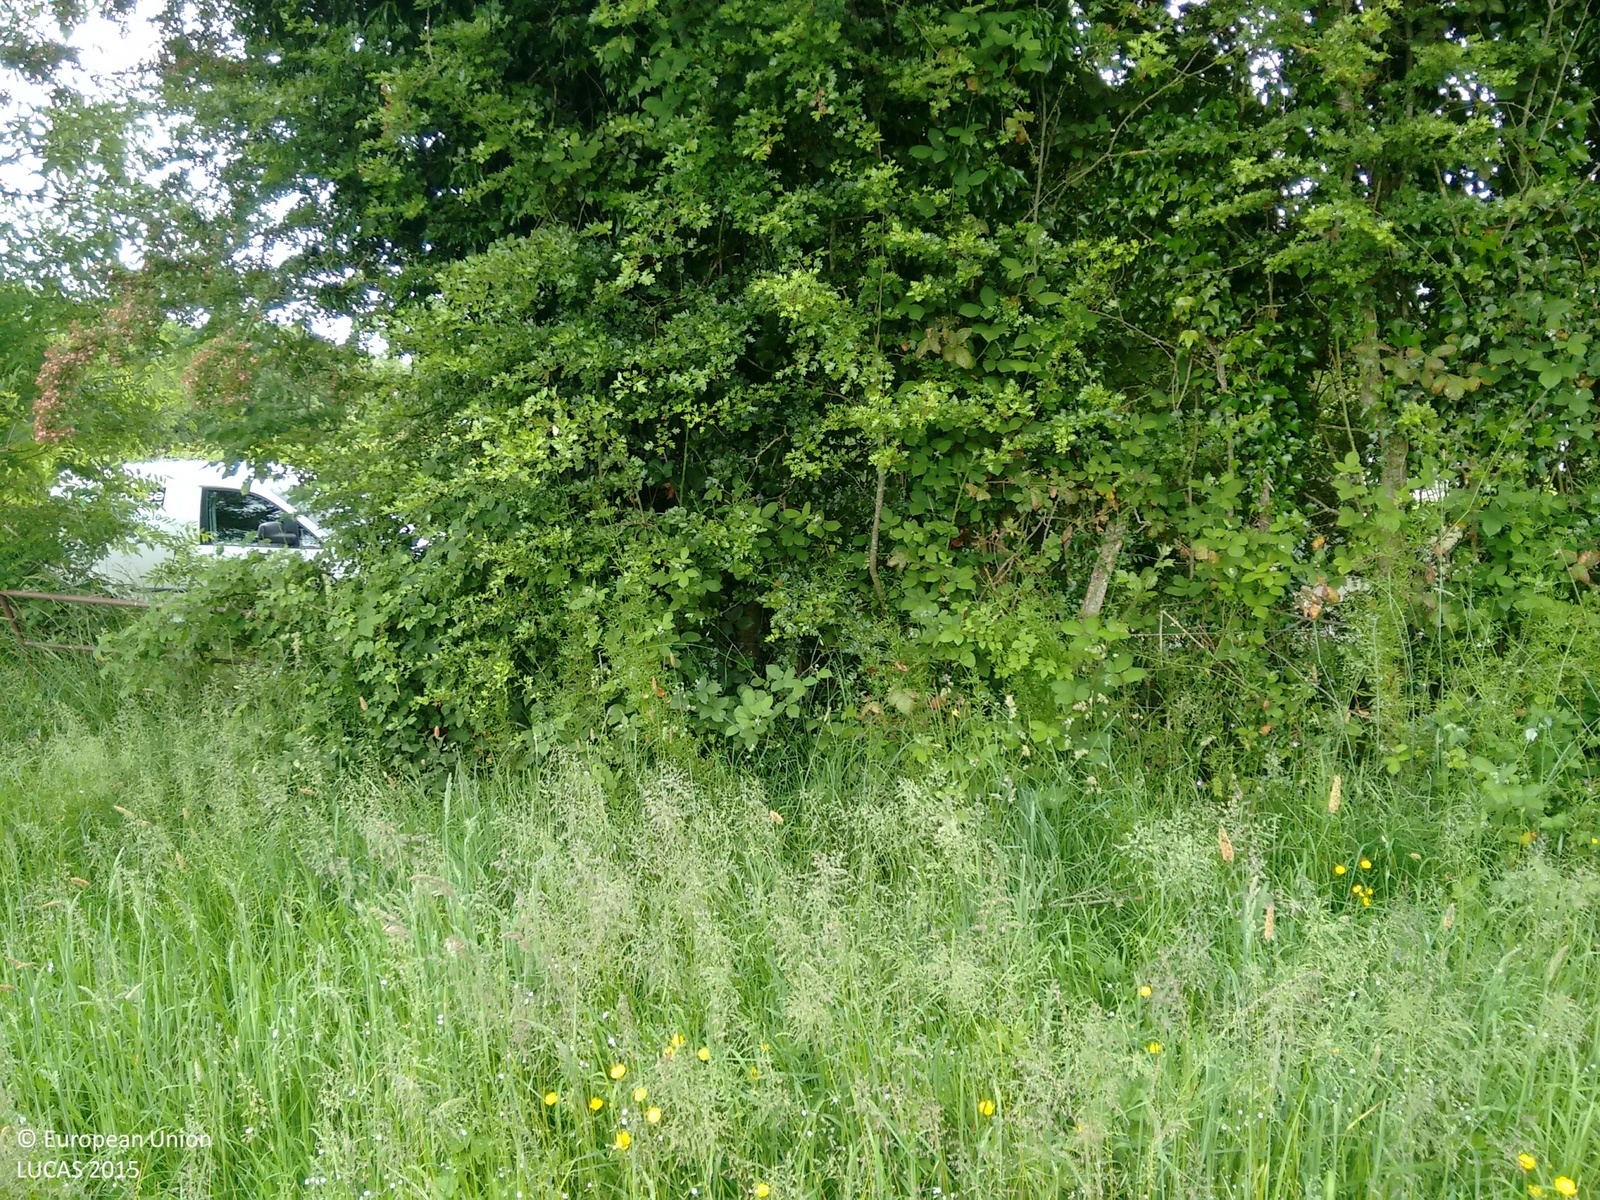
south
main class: Grassland
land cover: Grassland without tree/shrub cover
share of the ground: > 75 %
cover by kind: herbaceous plants 100 %
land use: Agriculture (excluding fallow land and kitchen gardens)
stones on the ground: < 10 %
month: June
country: IE
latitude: 53.6208
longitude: -6.7491
